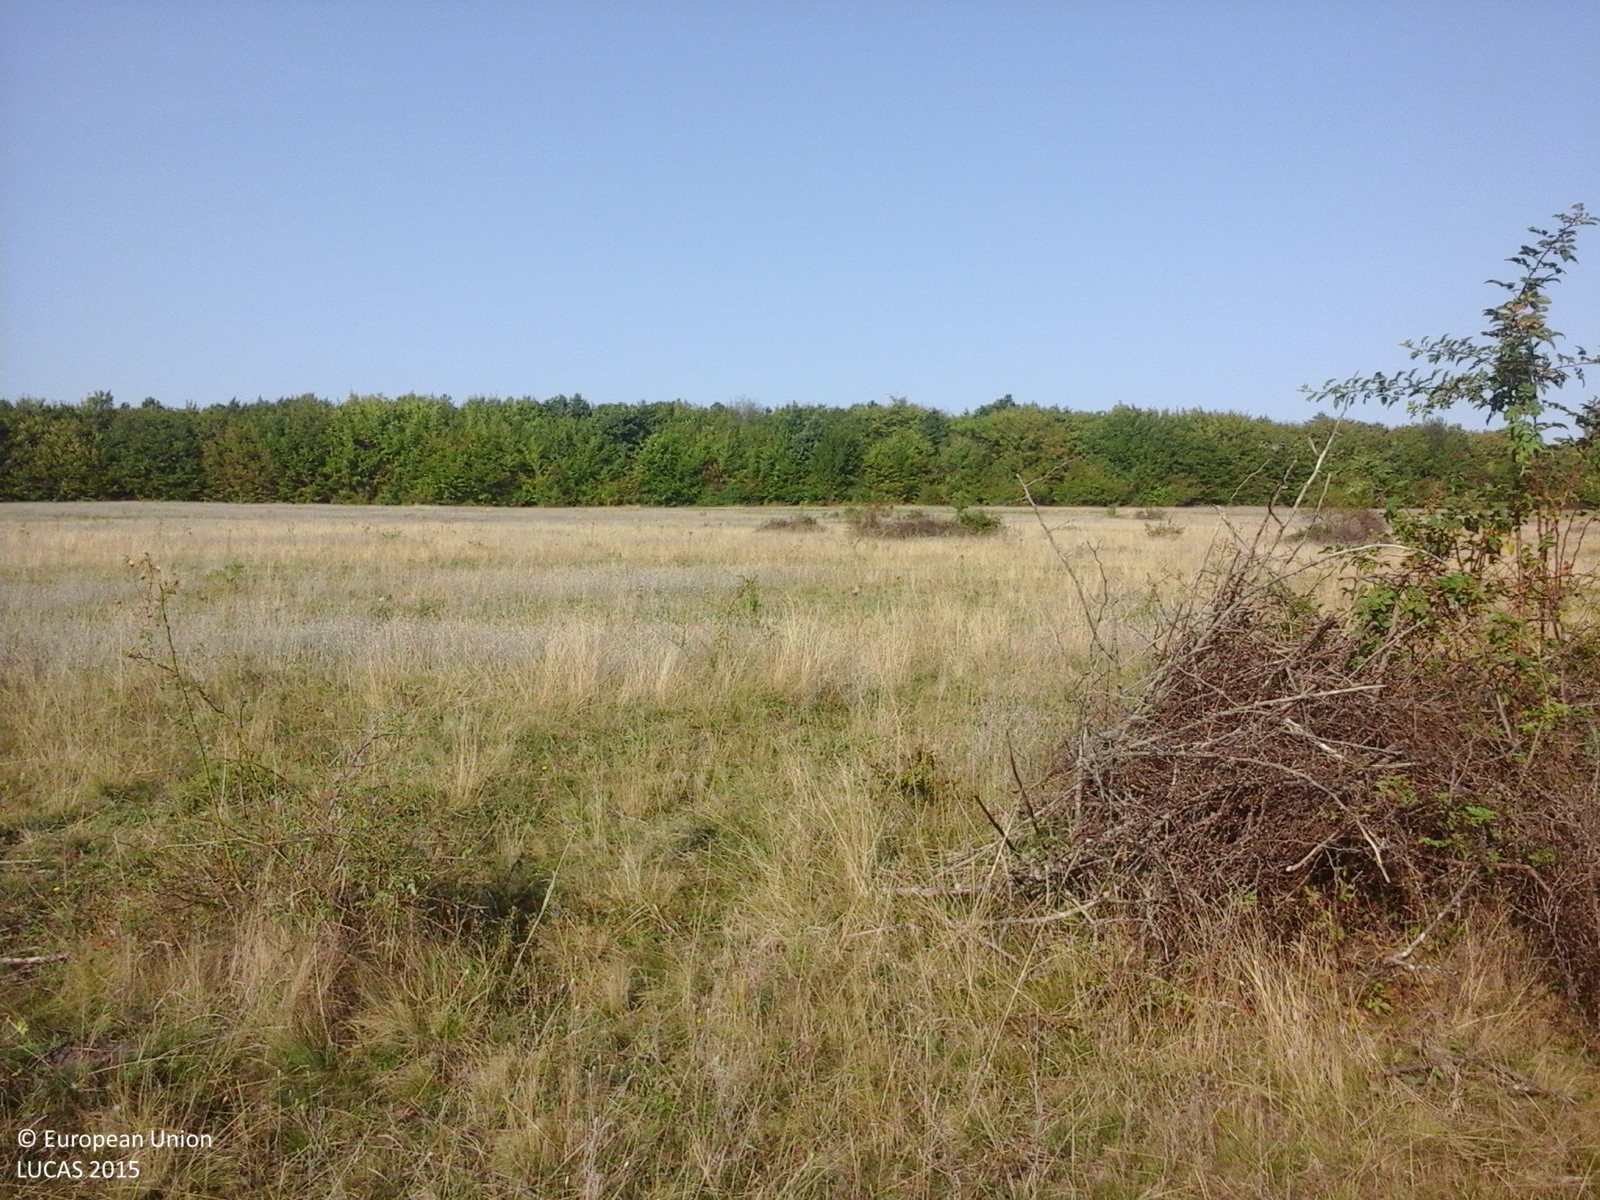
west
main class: Grassland
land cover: Grassland without tree/shrub cover
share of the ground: > 75 %
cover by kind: herbaceous plants 100 %
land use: Agriculture (excluding fallow land and kitchen gardens)
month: September
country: RO
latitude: 47.0530
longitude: 23.6997
